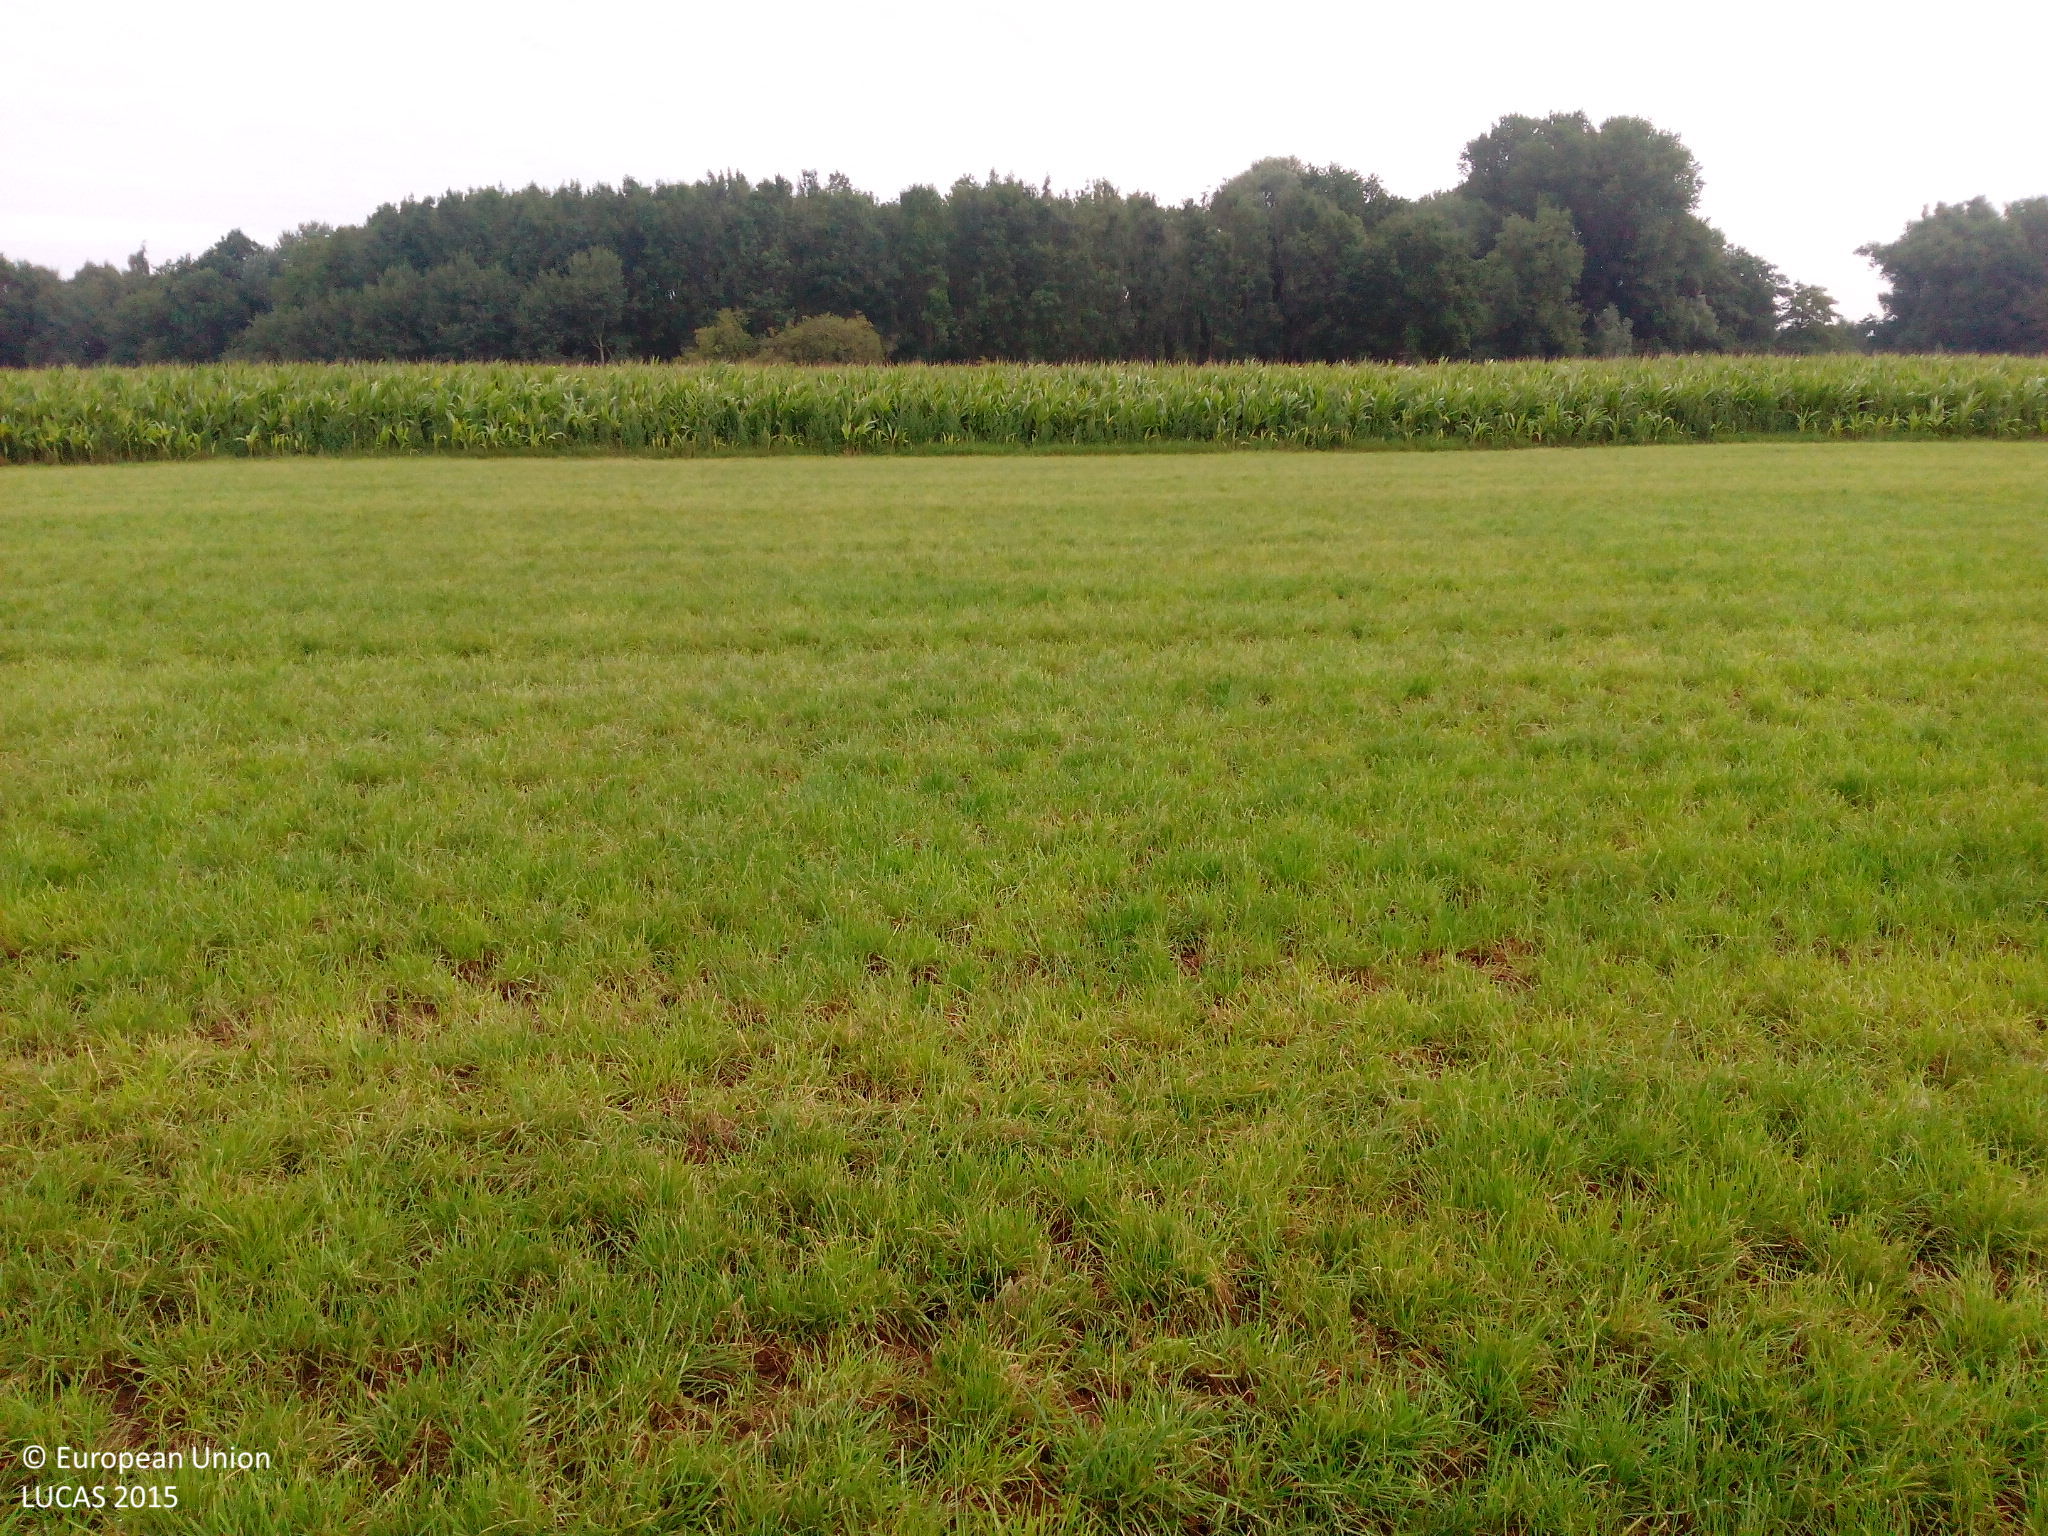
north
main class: Grassland
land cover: Grassland without tree/shrub cover
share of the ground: > 75 %
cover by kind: herbaceous plants 100 %
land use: Agriculture (excluding fallow land and kitchen gardens)
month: August
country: NL
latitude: 51.7013
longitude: 5.5852
